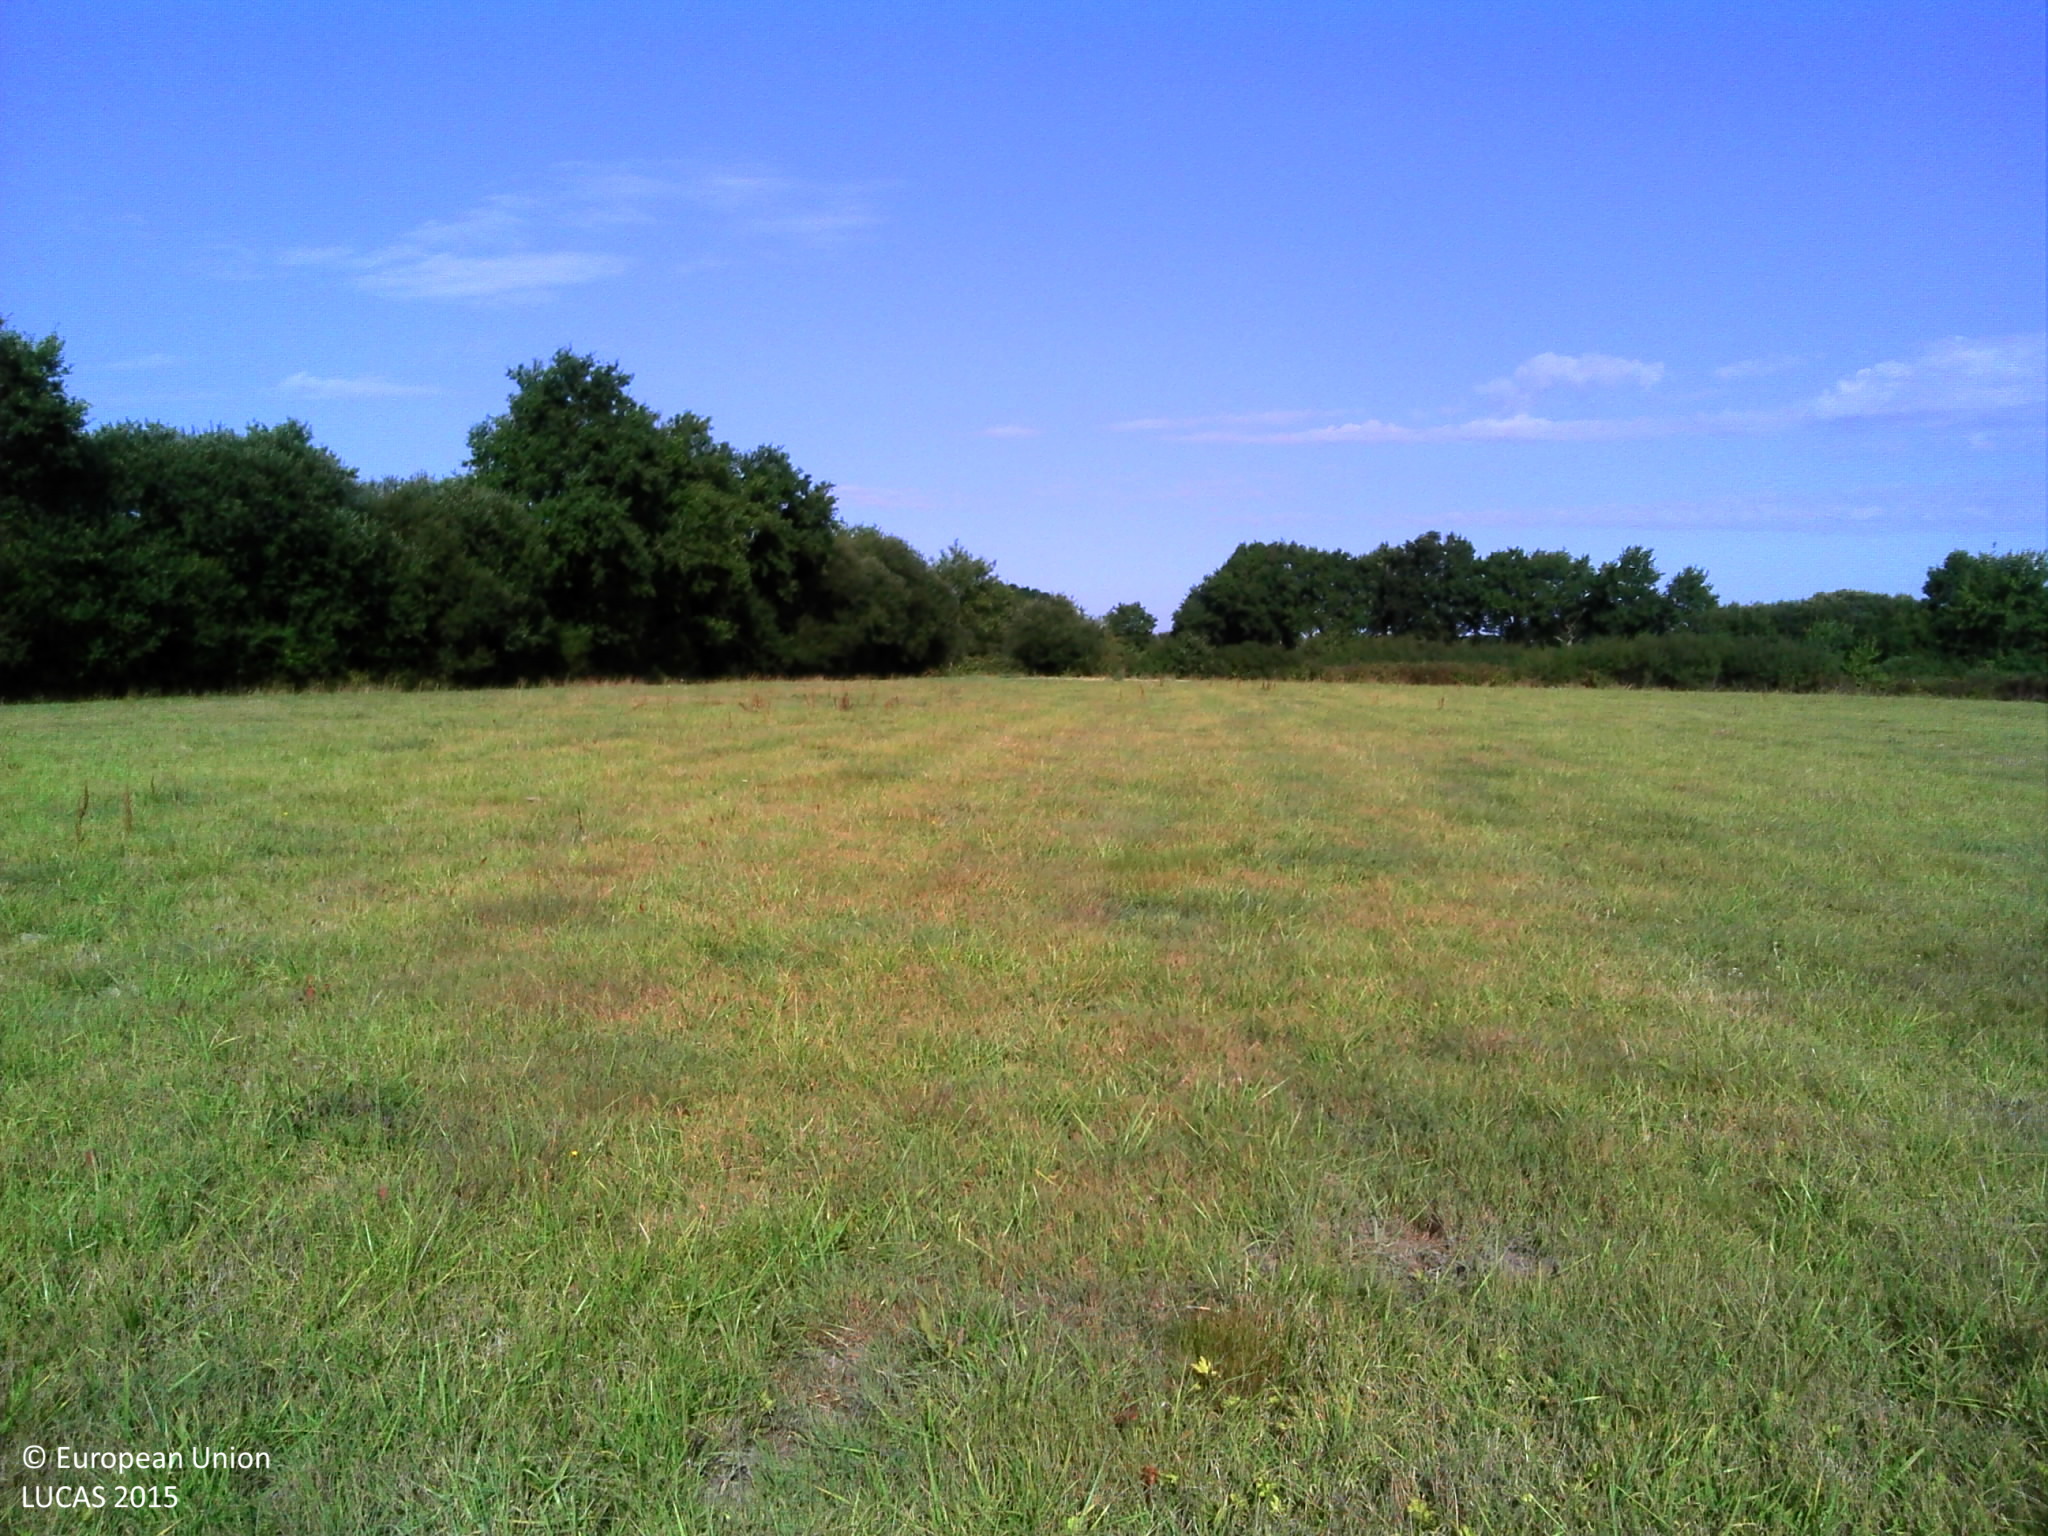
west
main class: Cropland
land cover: Temporary grasslands
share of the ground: > 75 %
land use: Agriculture (excluding fallow land and kitchen gardens)
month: August
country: FR
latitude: 47.4409
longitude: -1.8086
